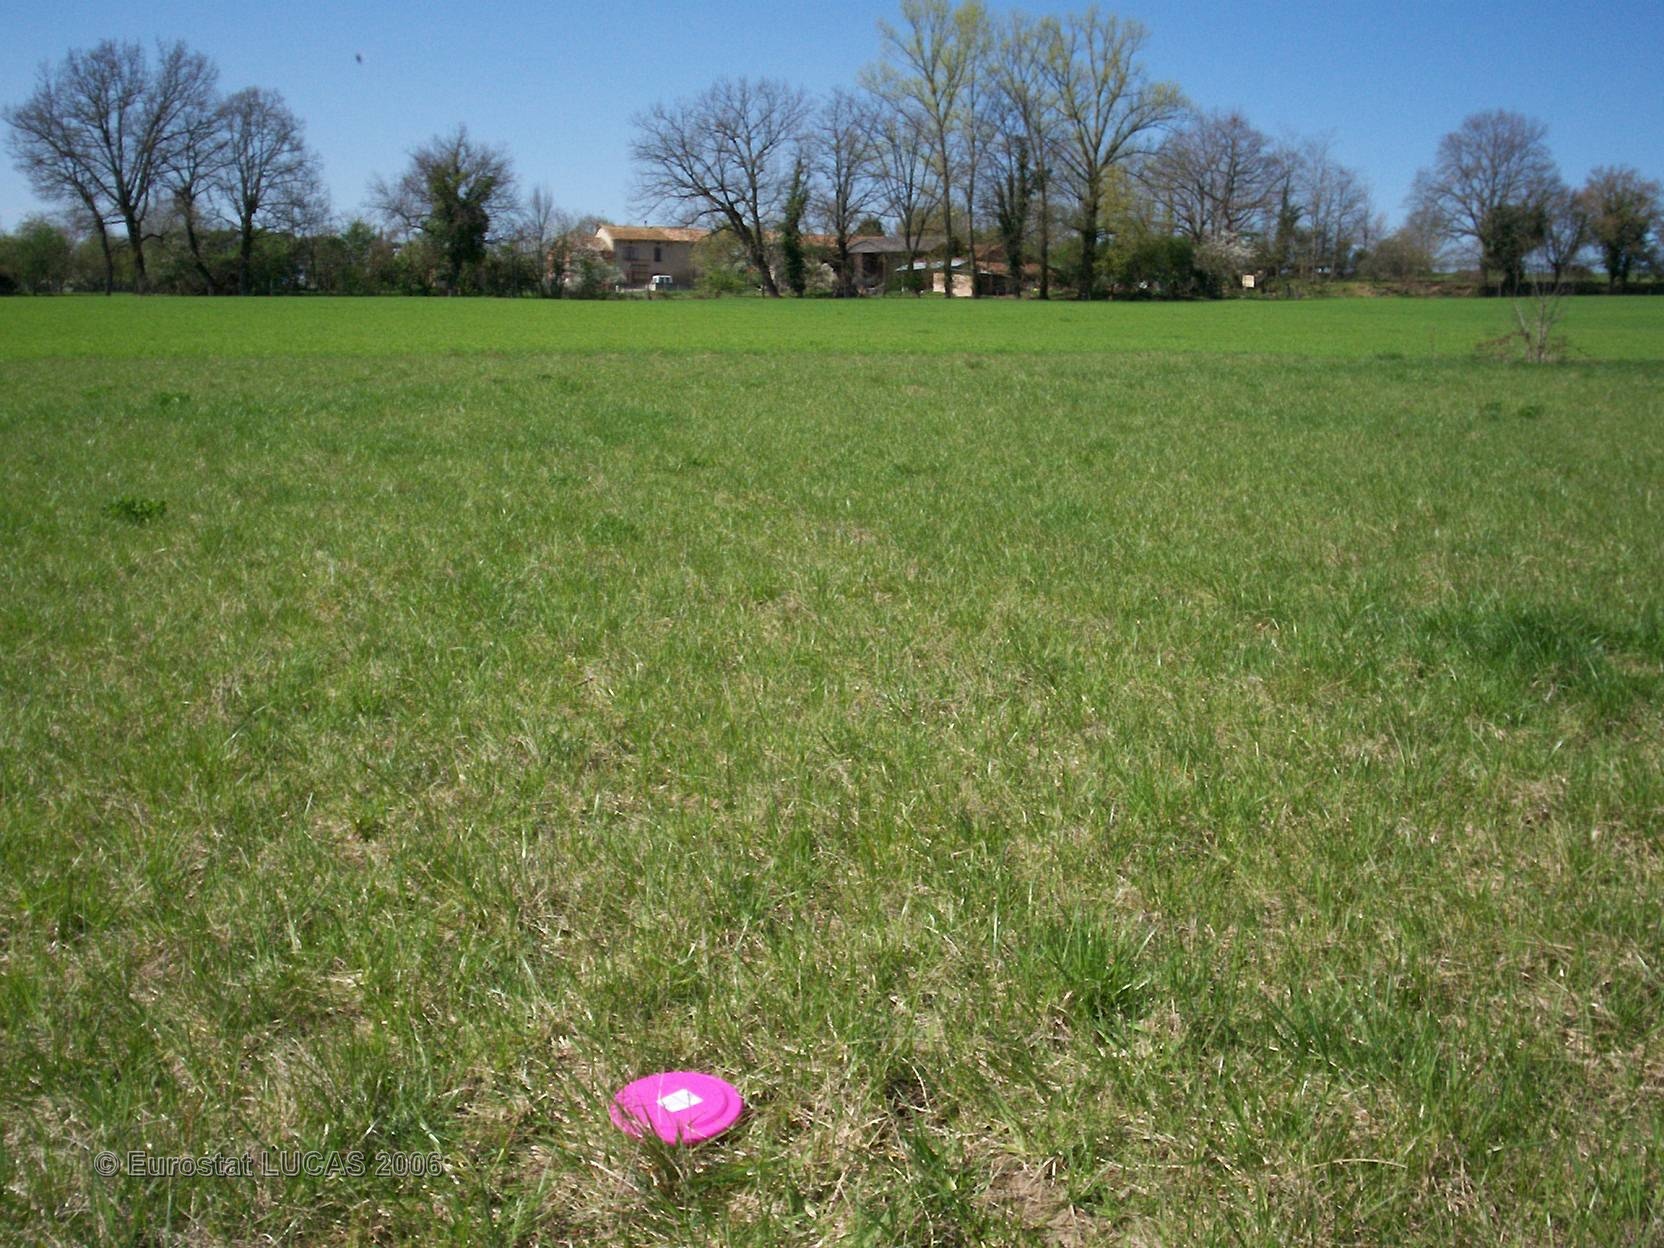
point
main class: Grassland
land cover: Grassland without tree/shrub cover
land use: Agriculture (excluding fallow land and kitchen gardens)
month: April
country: FR
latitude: 43.5358
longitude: 2.0236
